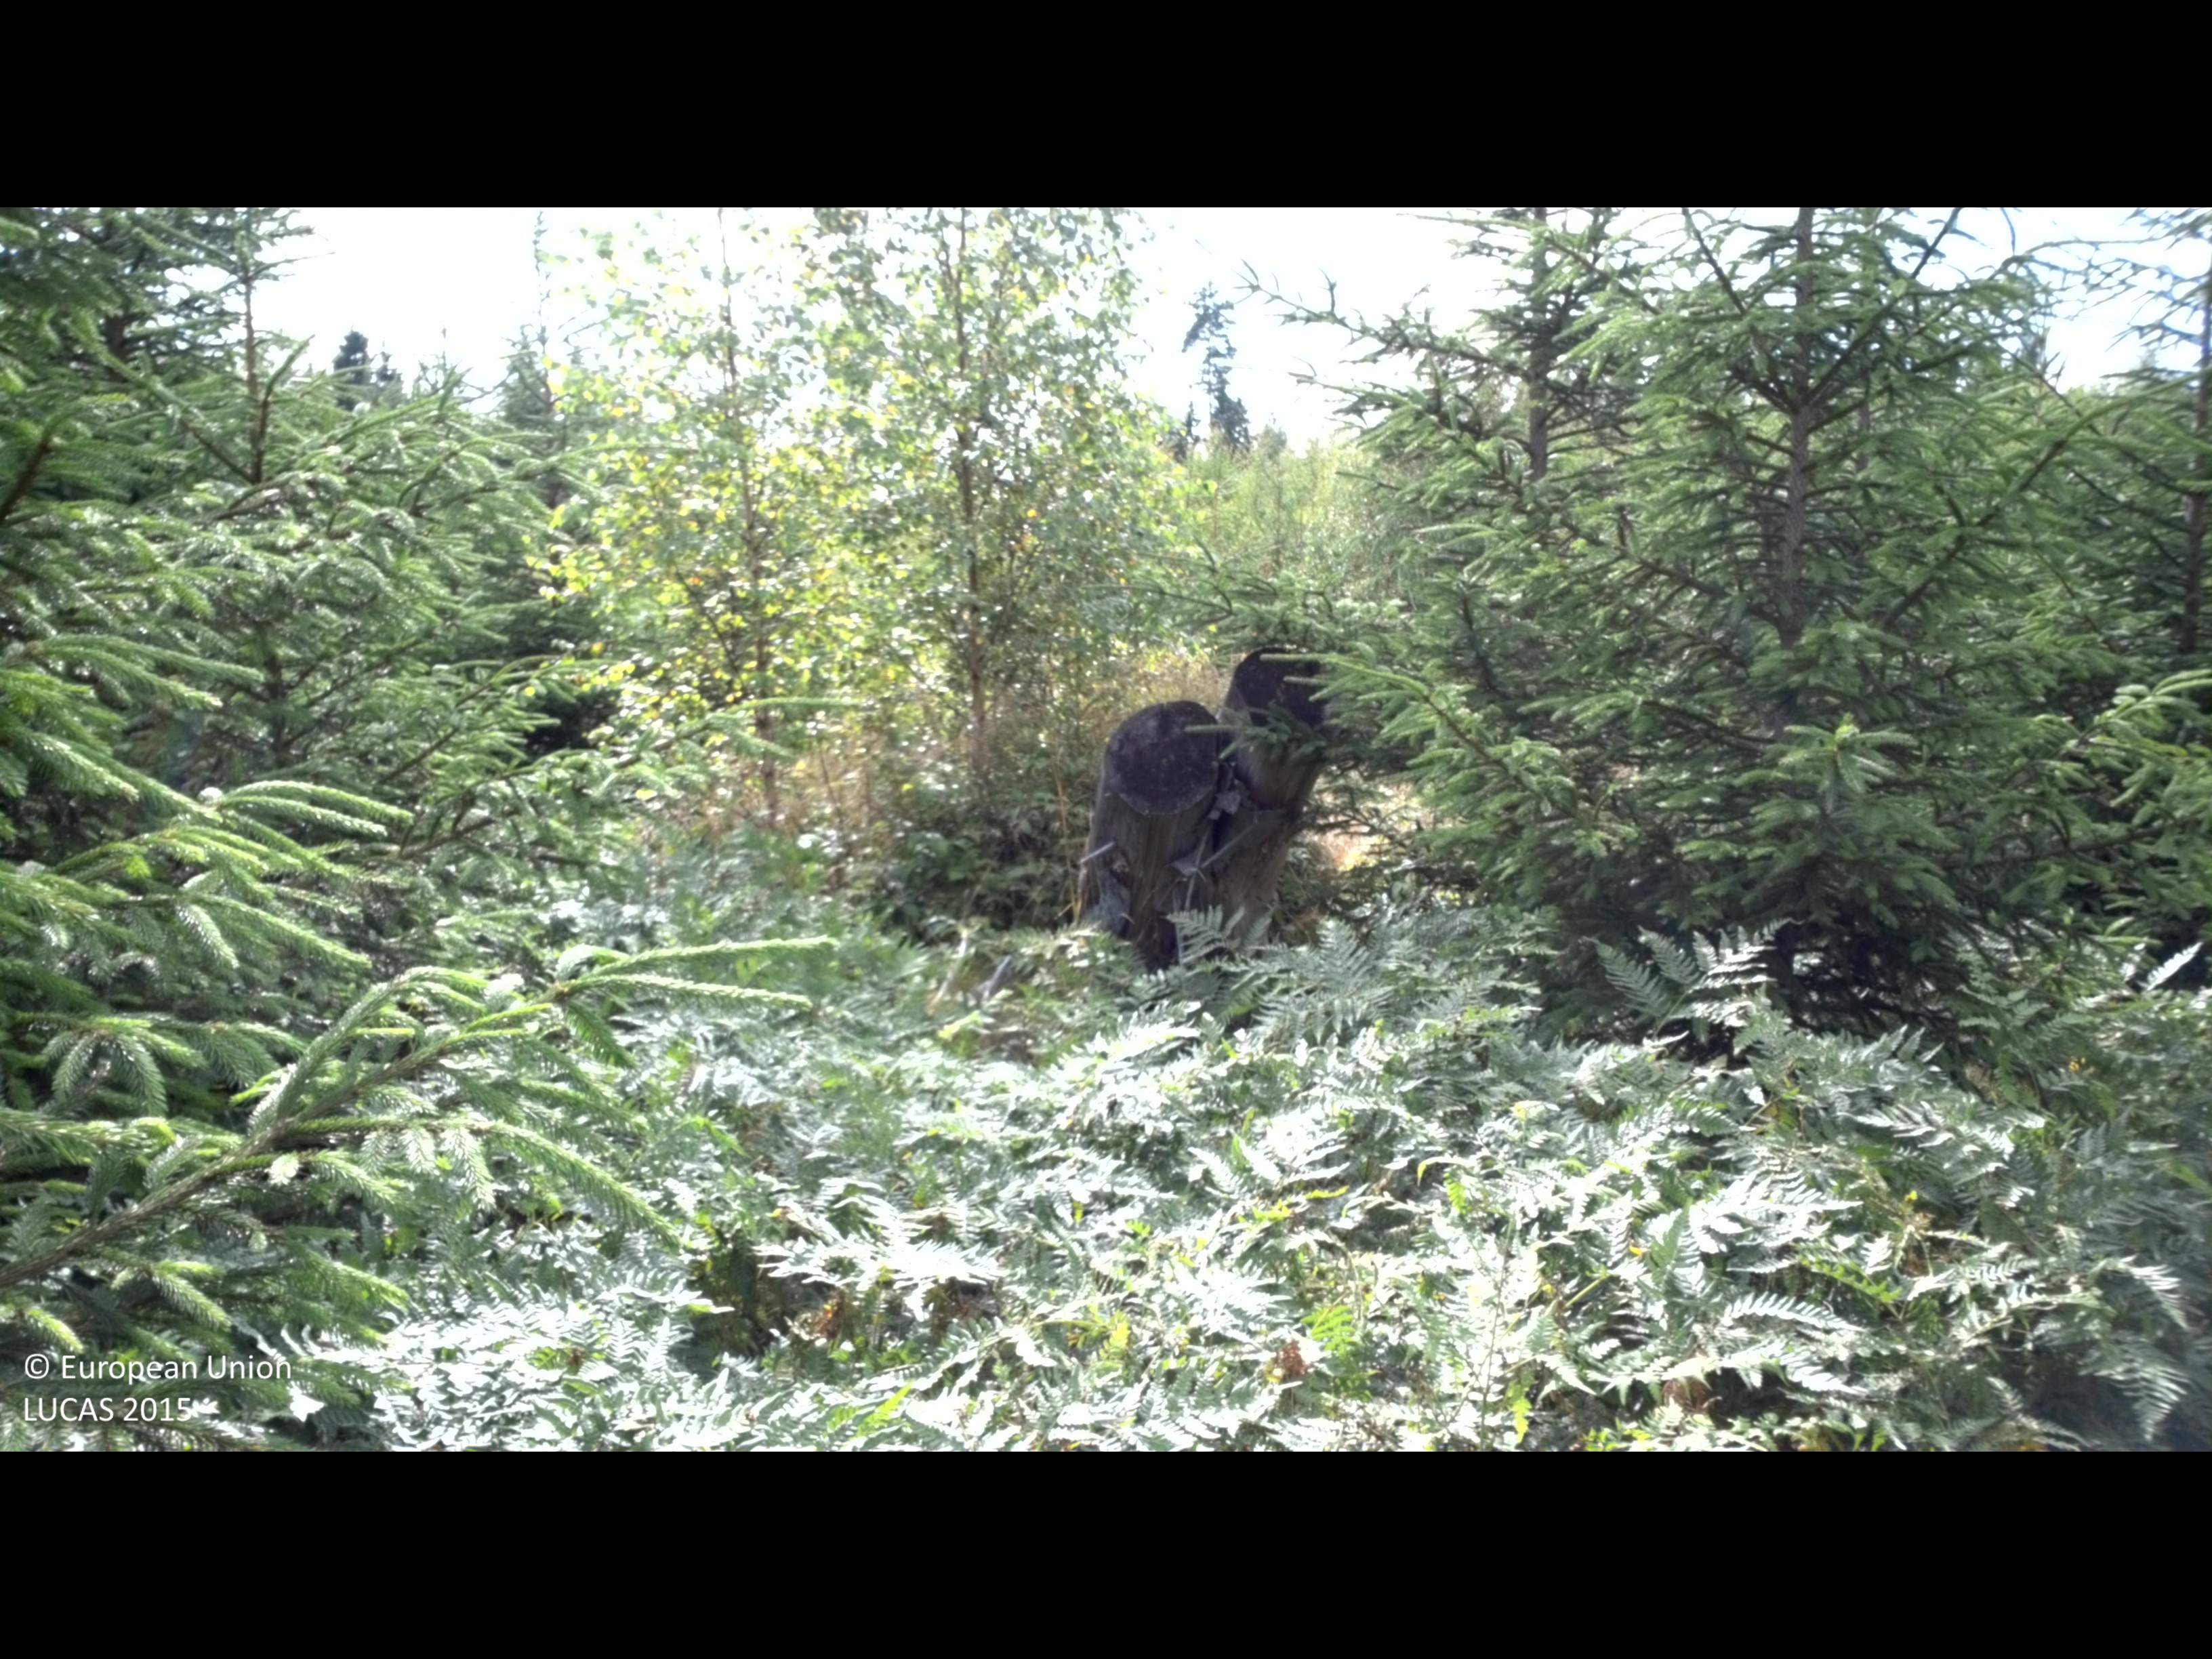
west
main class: Woodland
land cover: Spruce dominated coniferous woodland
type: boreal forest
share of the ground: 50 - 75 %
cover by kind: coniferous forest trees 55 %, shrubs 25 %, herbaceous plants 20 %
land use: Forestry
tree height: < 5 m
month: August
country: SE
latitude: 56.3735
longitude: 14.1262
